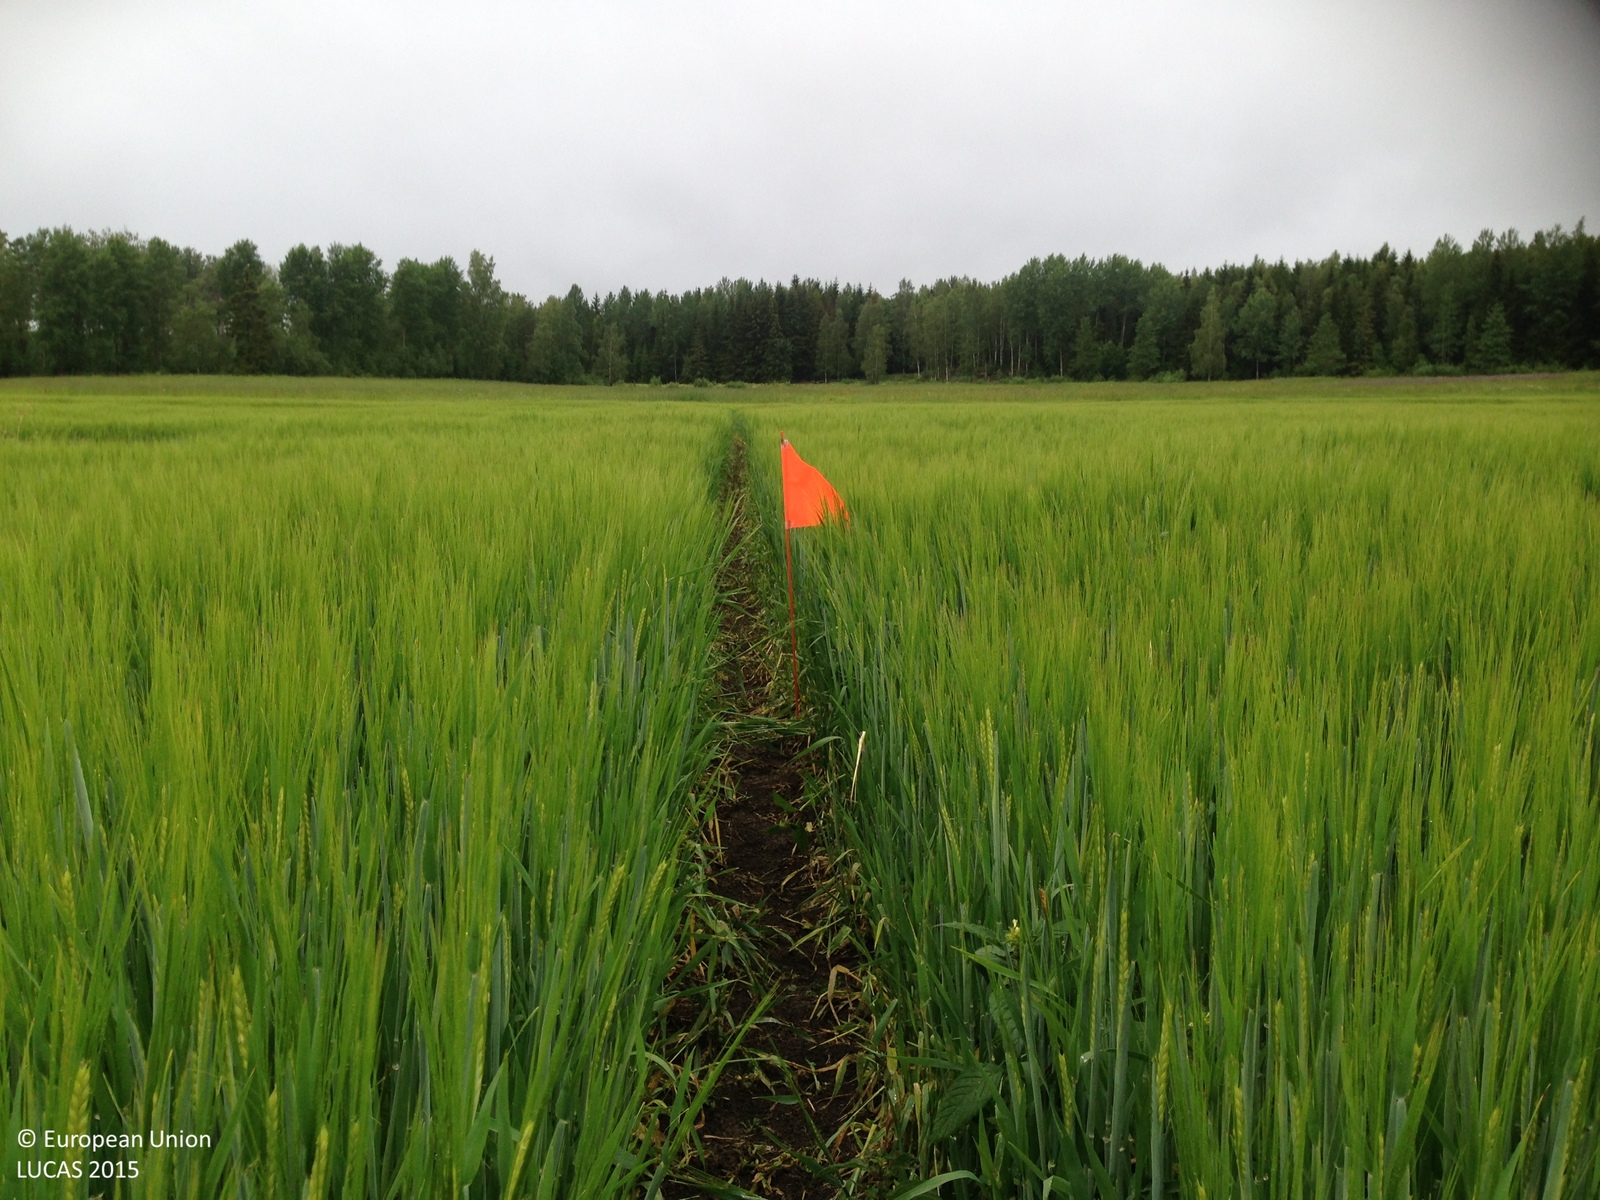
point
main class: Cropland
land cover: Barley
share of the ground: > 75 %
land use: Agriculture (excluding fallow land and kitchen gardens)
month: July
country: SE
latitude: 59.9010
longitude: 16.9460
